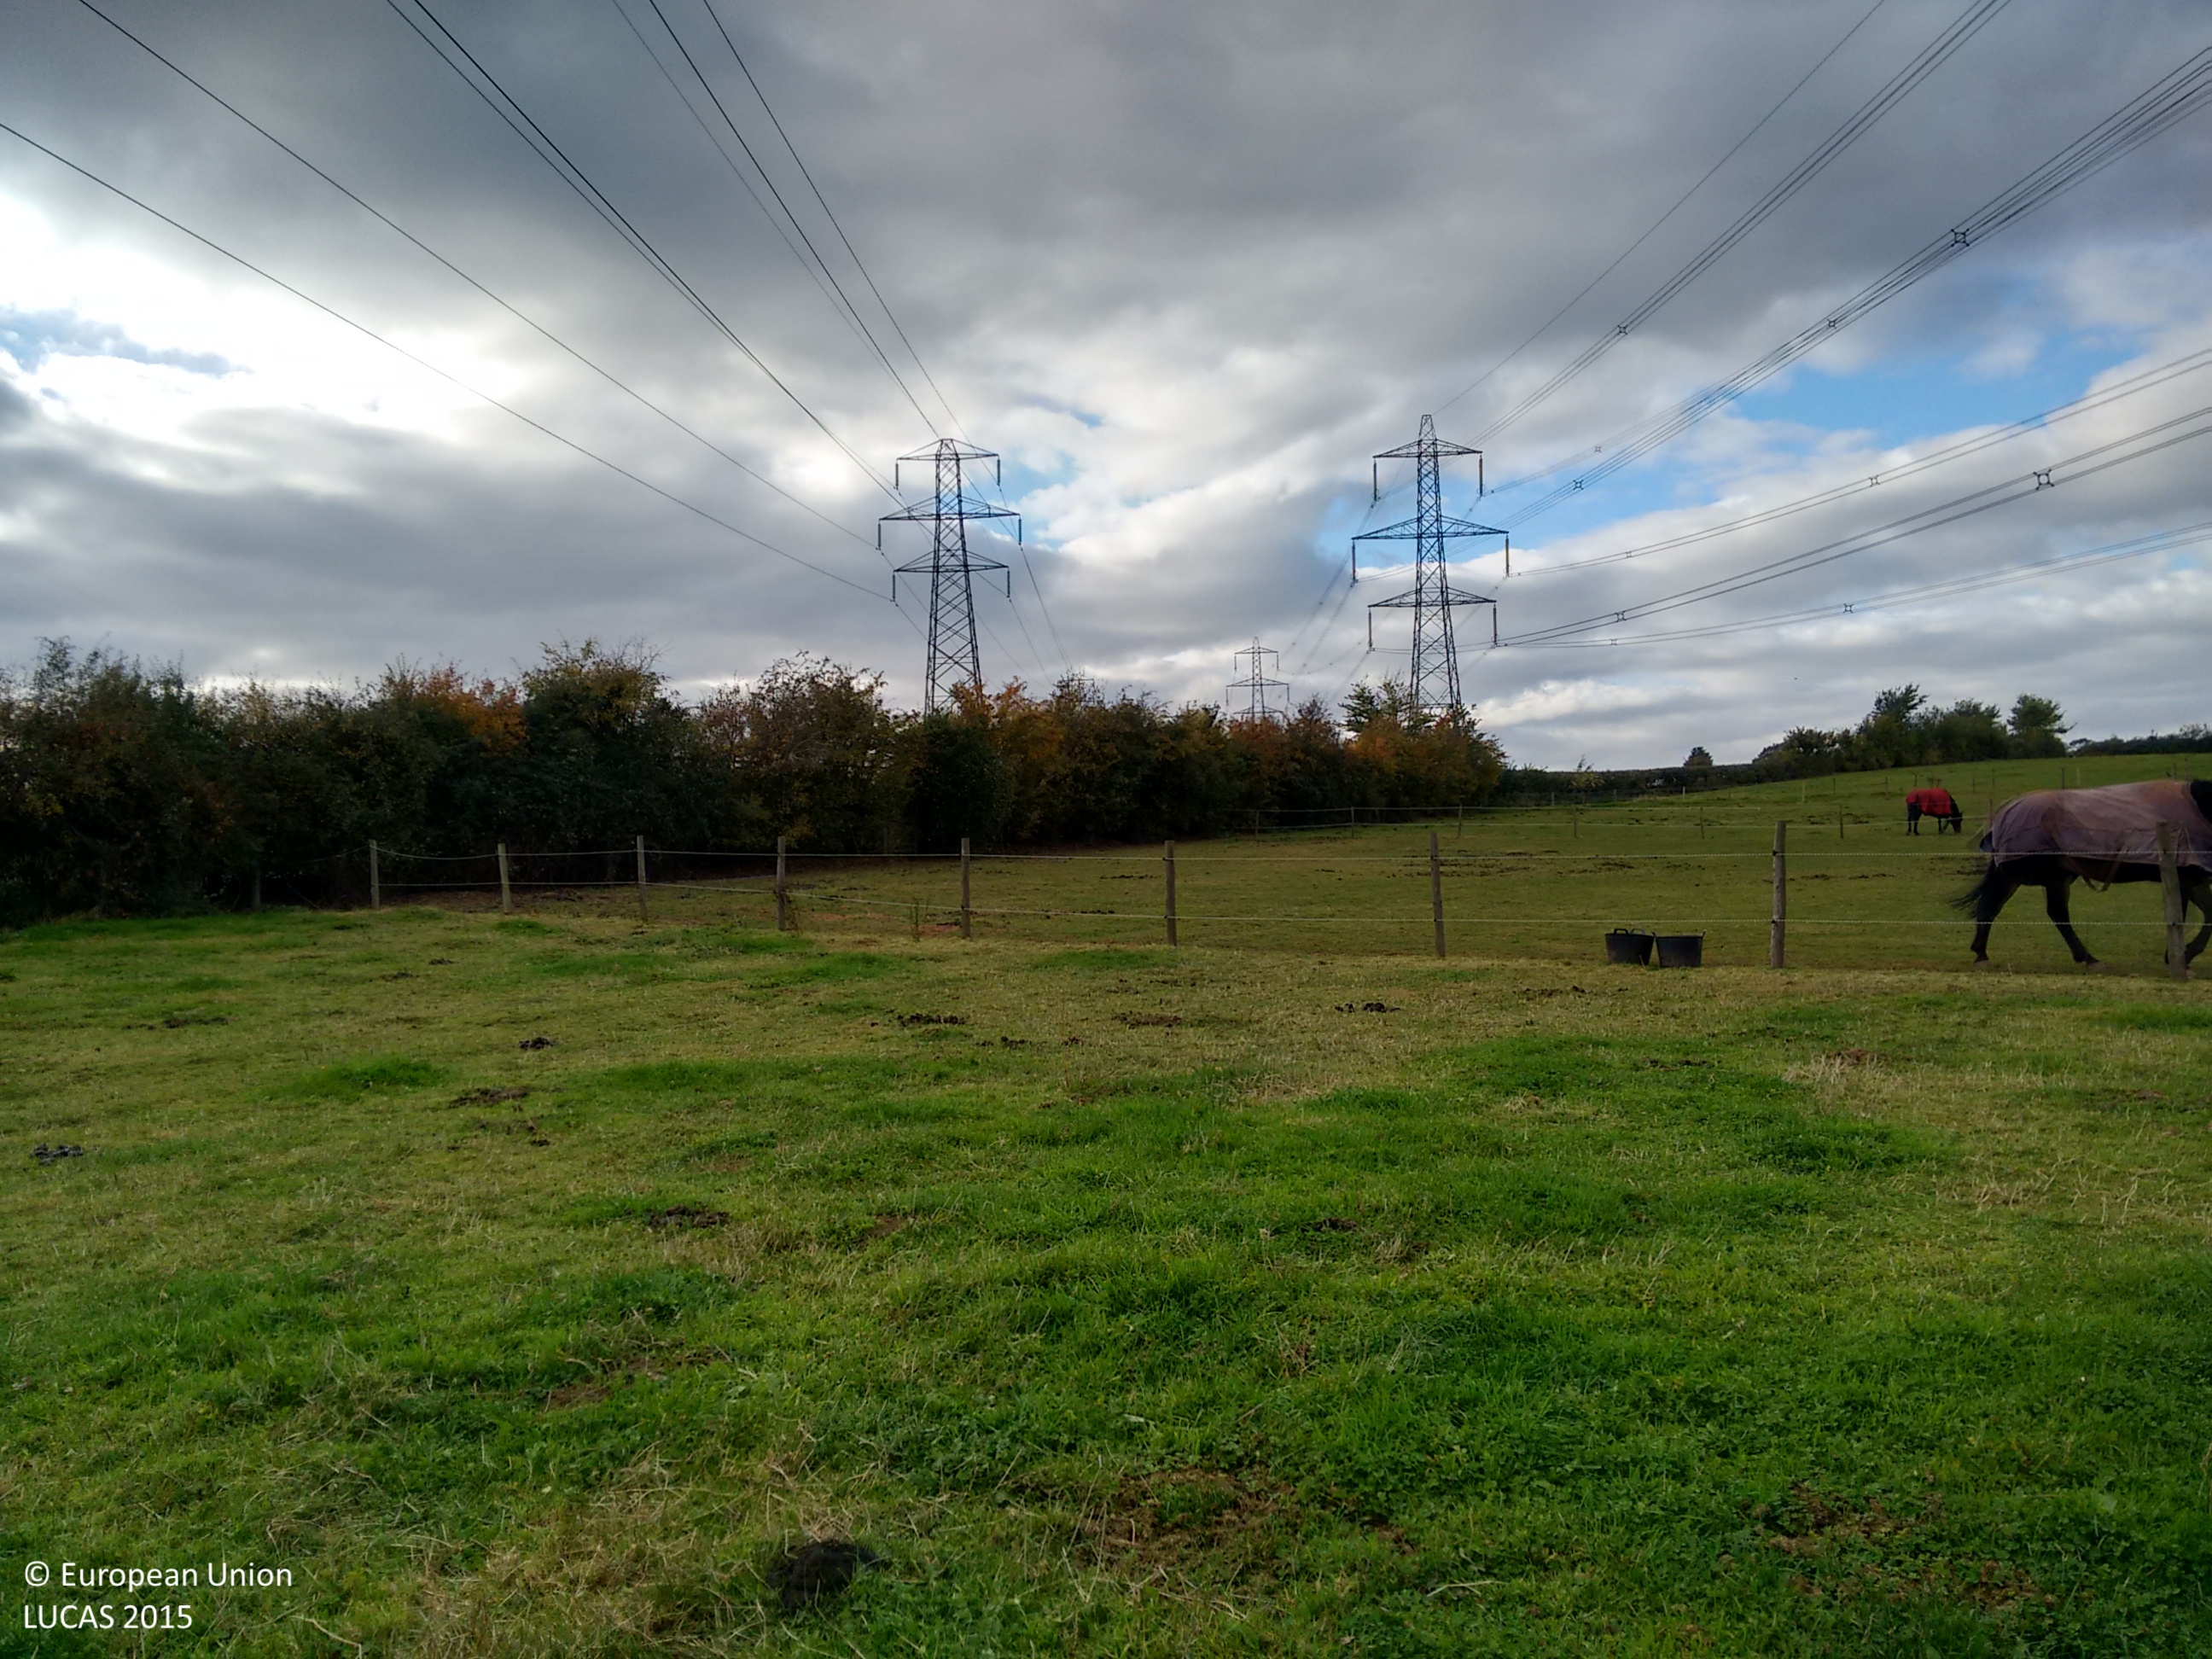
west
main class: Grassland
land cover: Grassland without tree/shrub cover
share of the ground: > 75 %
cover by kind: herbaceous plants 100 %
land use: Agriculture (excluding fallow land and kitchen gardens)
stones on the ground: < 10 %
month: October
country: GB
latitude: 51.8965
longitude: -2.4914
